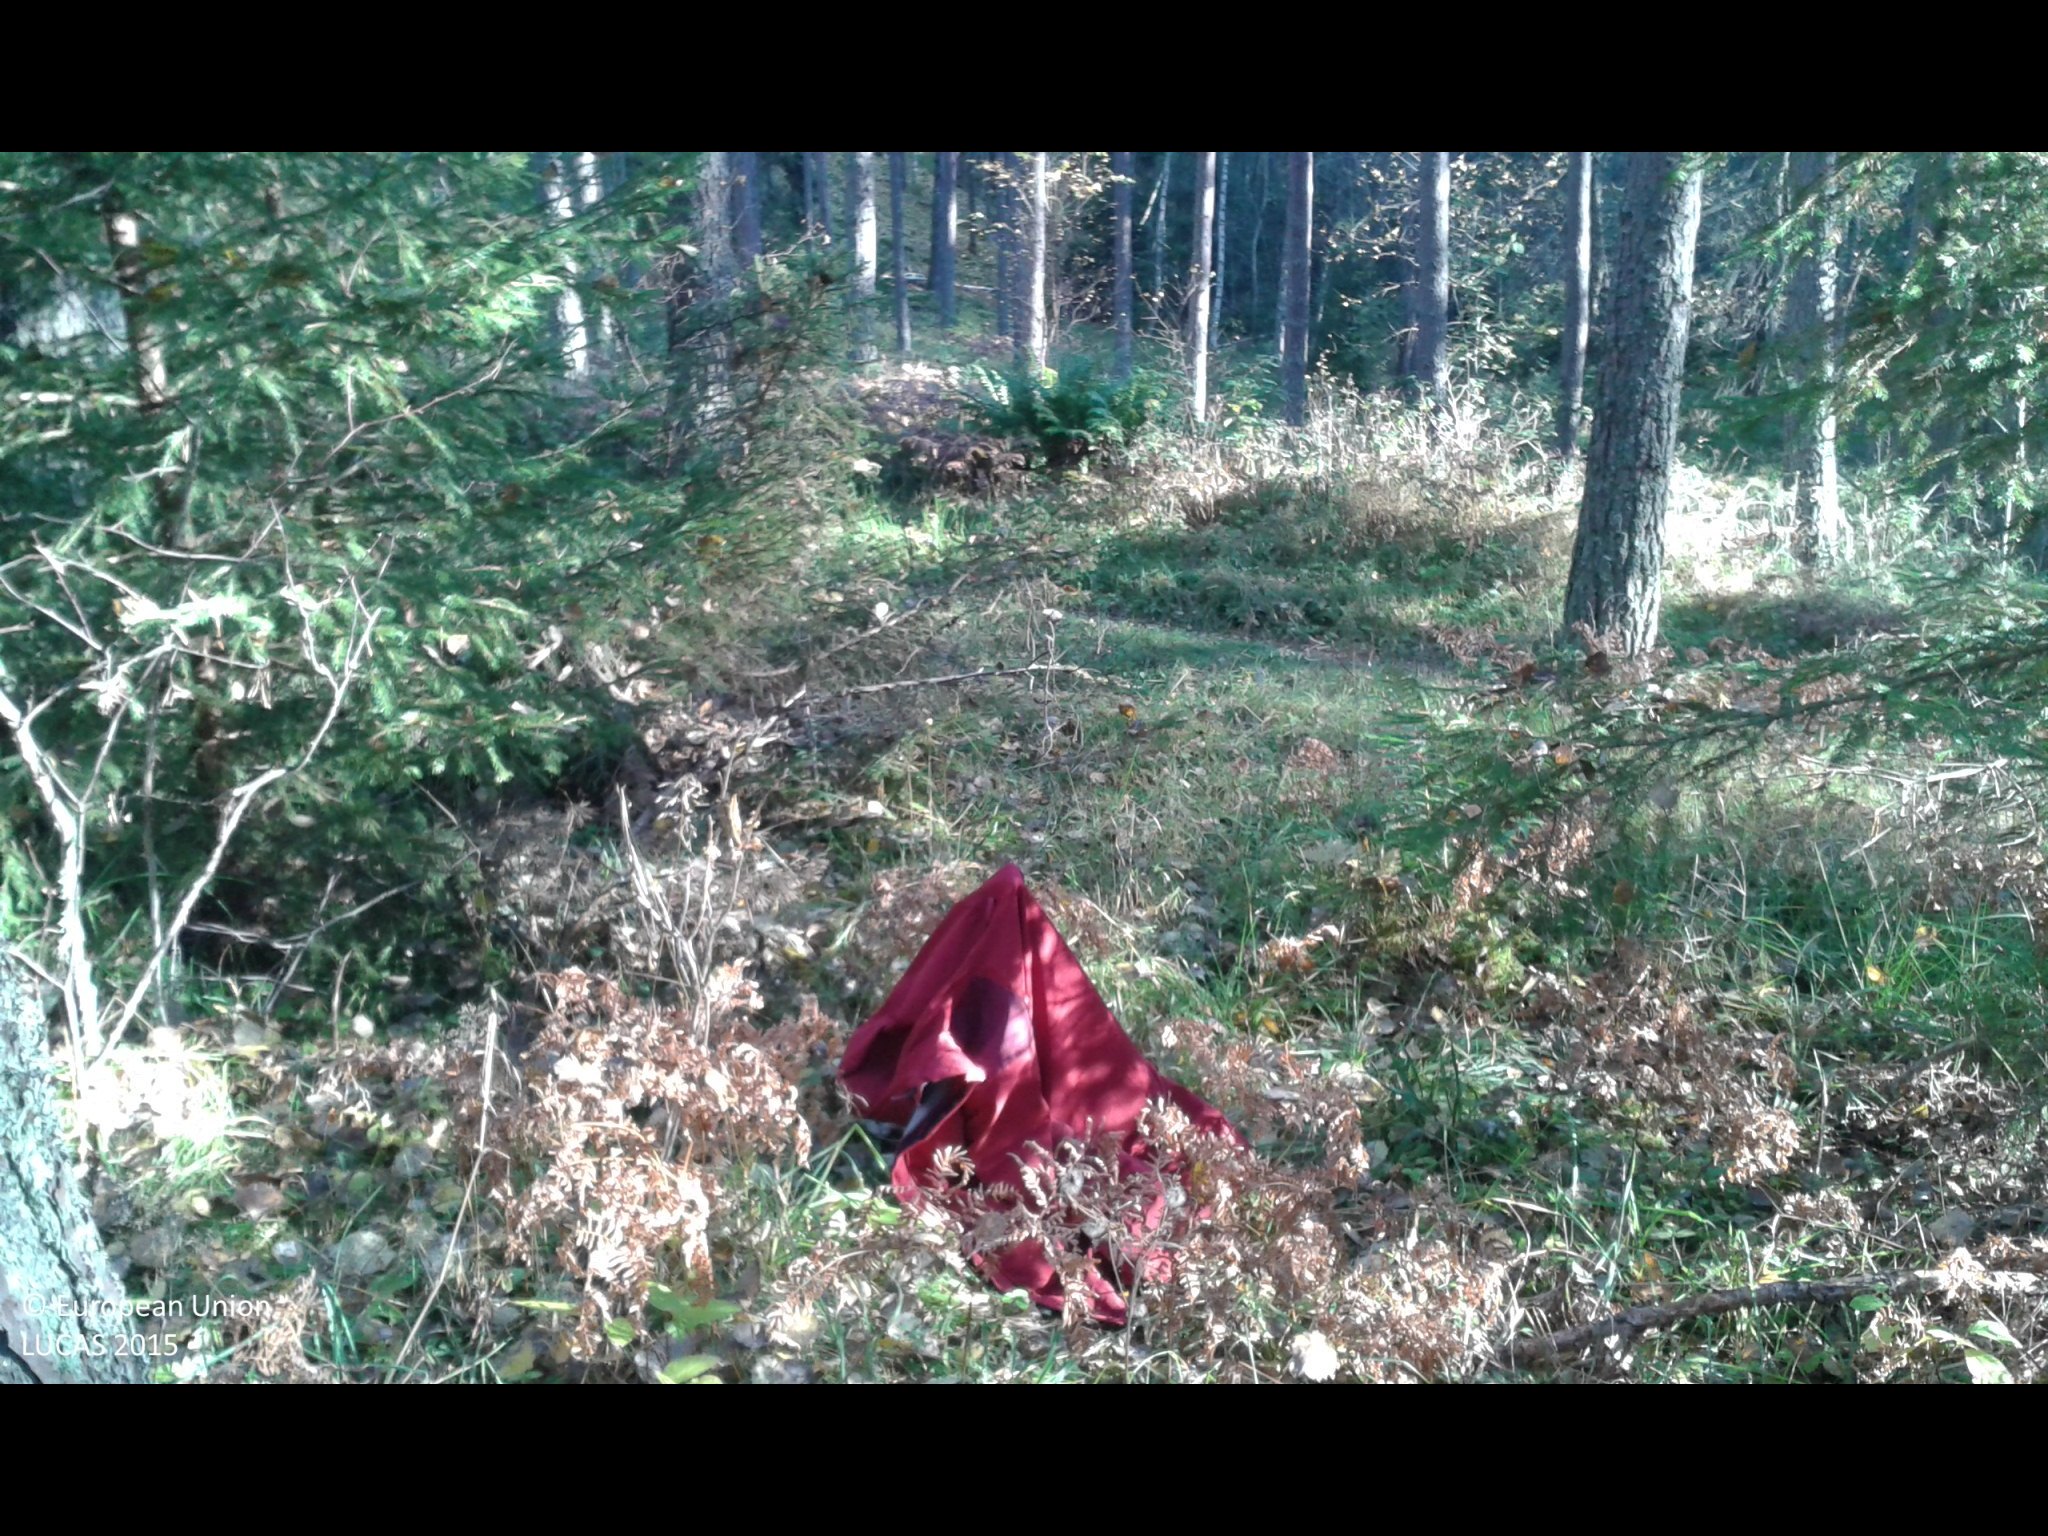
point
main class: Woodland
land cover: Pine dominated coniferous woodland
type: boreal forest
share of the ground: 50 - 75 %
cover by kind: coniferous forest trees 55 %, herbaceous plants 30 %, broadleaved forest trees 15 %
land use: Forestry
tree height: > 5 m
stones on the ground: < 10 %
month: October
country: SE
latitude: 58.8866
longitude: 17.3366
